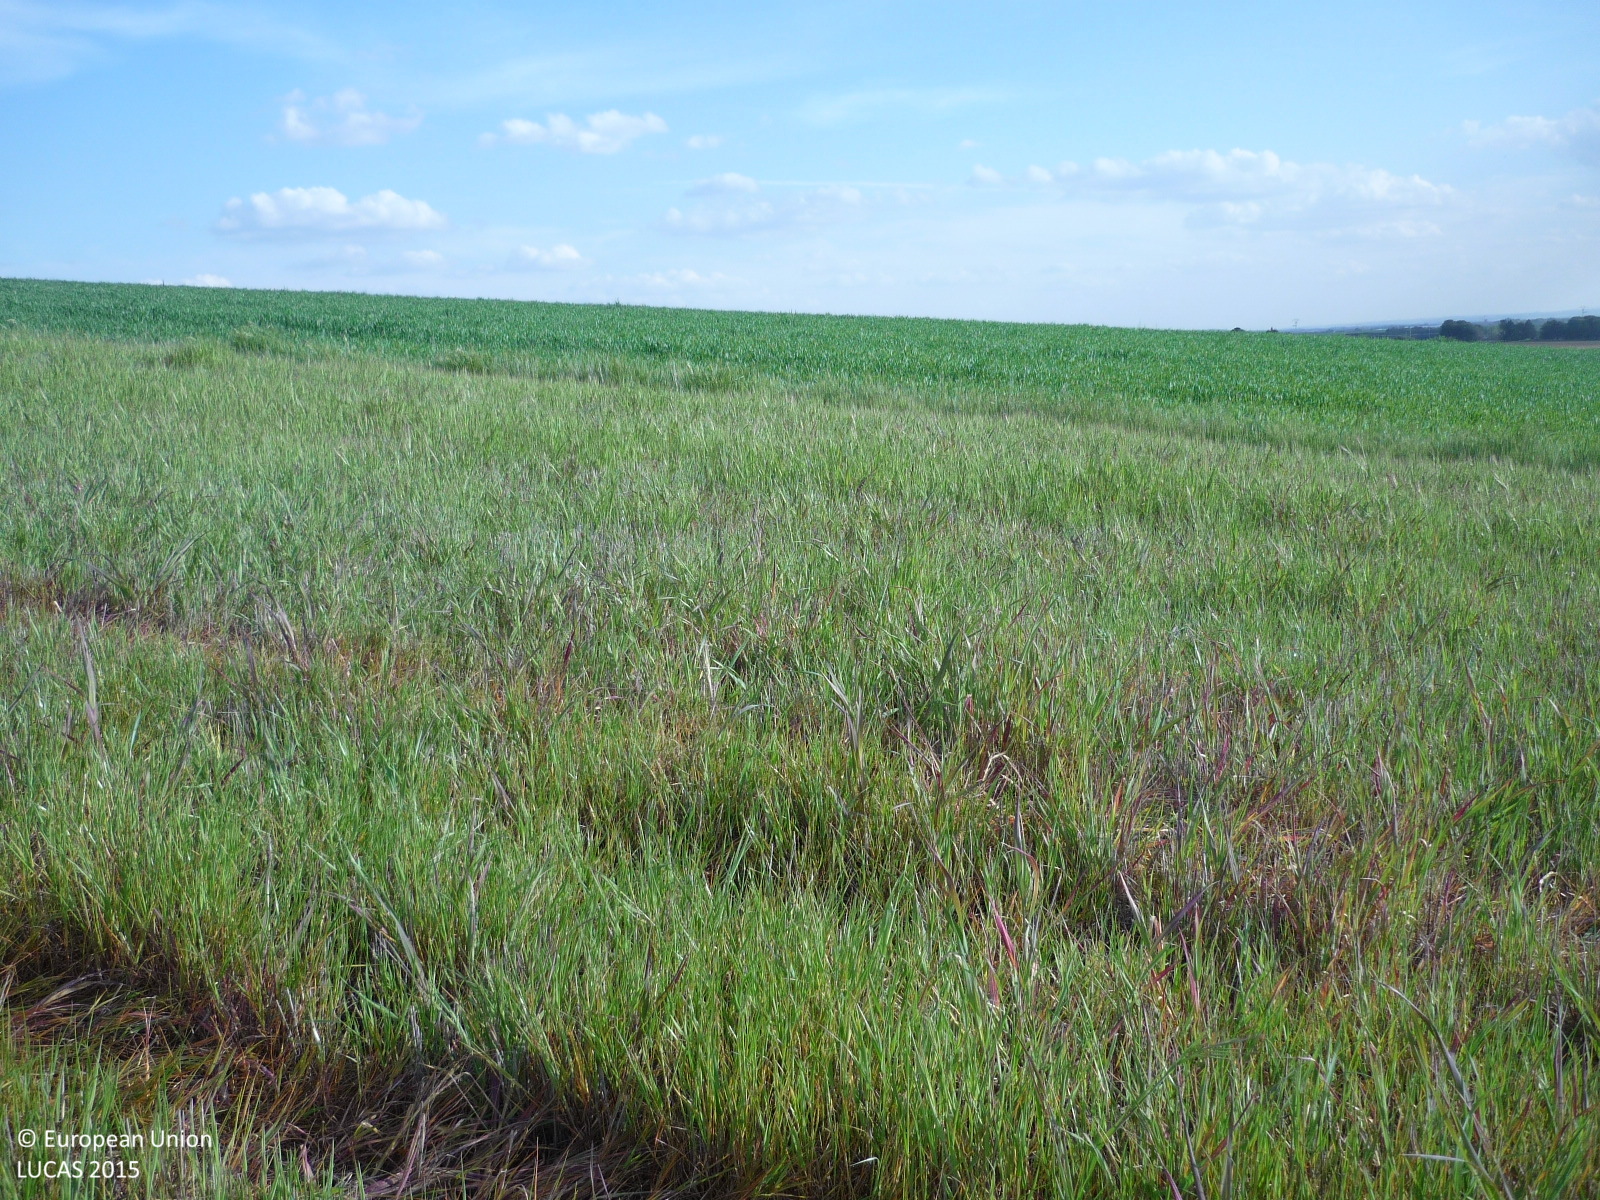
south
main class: Grassland
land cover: Spontaneously vegetated surfaces
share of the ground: > 75 %
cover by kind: herbaceous plants 90 %, unconsolidated bare surface 10 %
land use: Fallow land
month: April
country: ES
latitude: 40.7600
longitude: -3.4838
